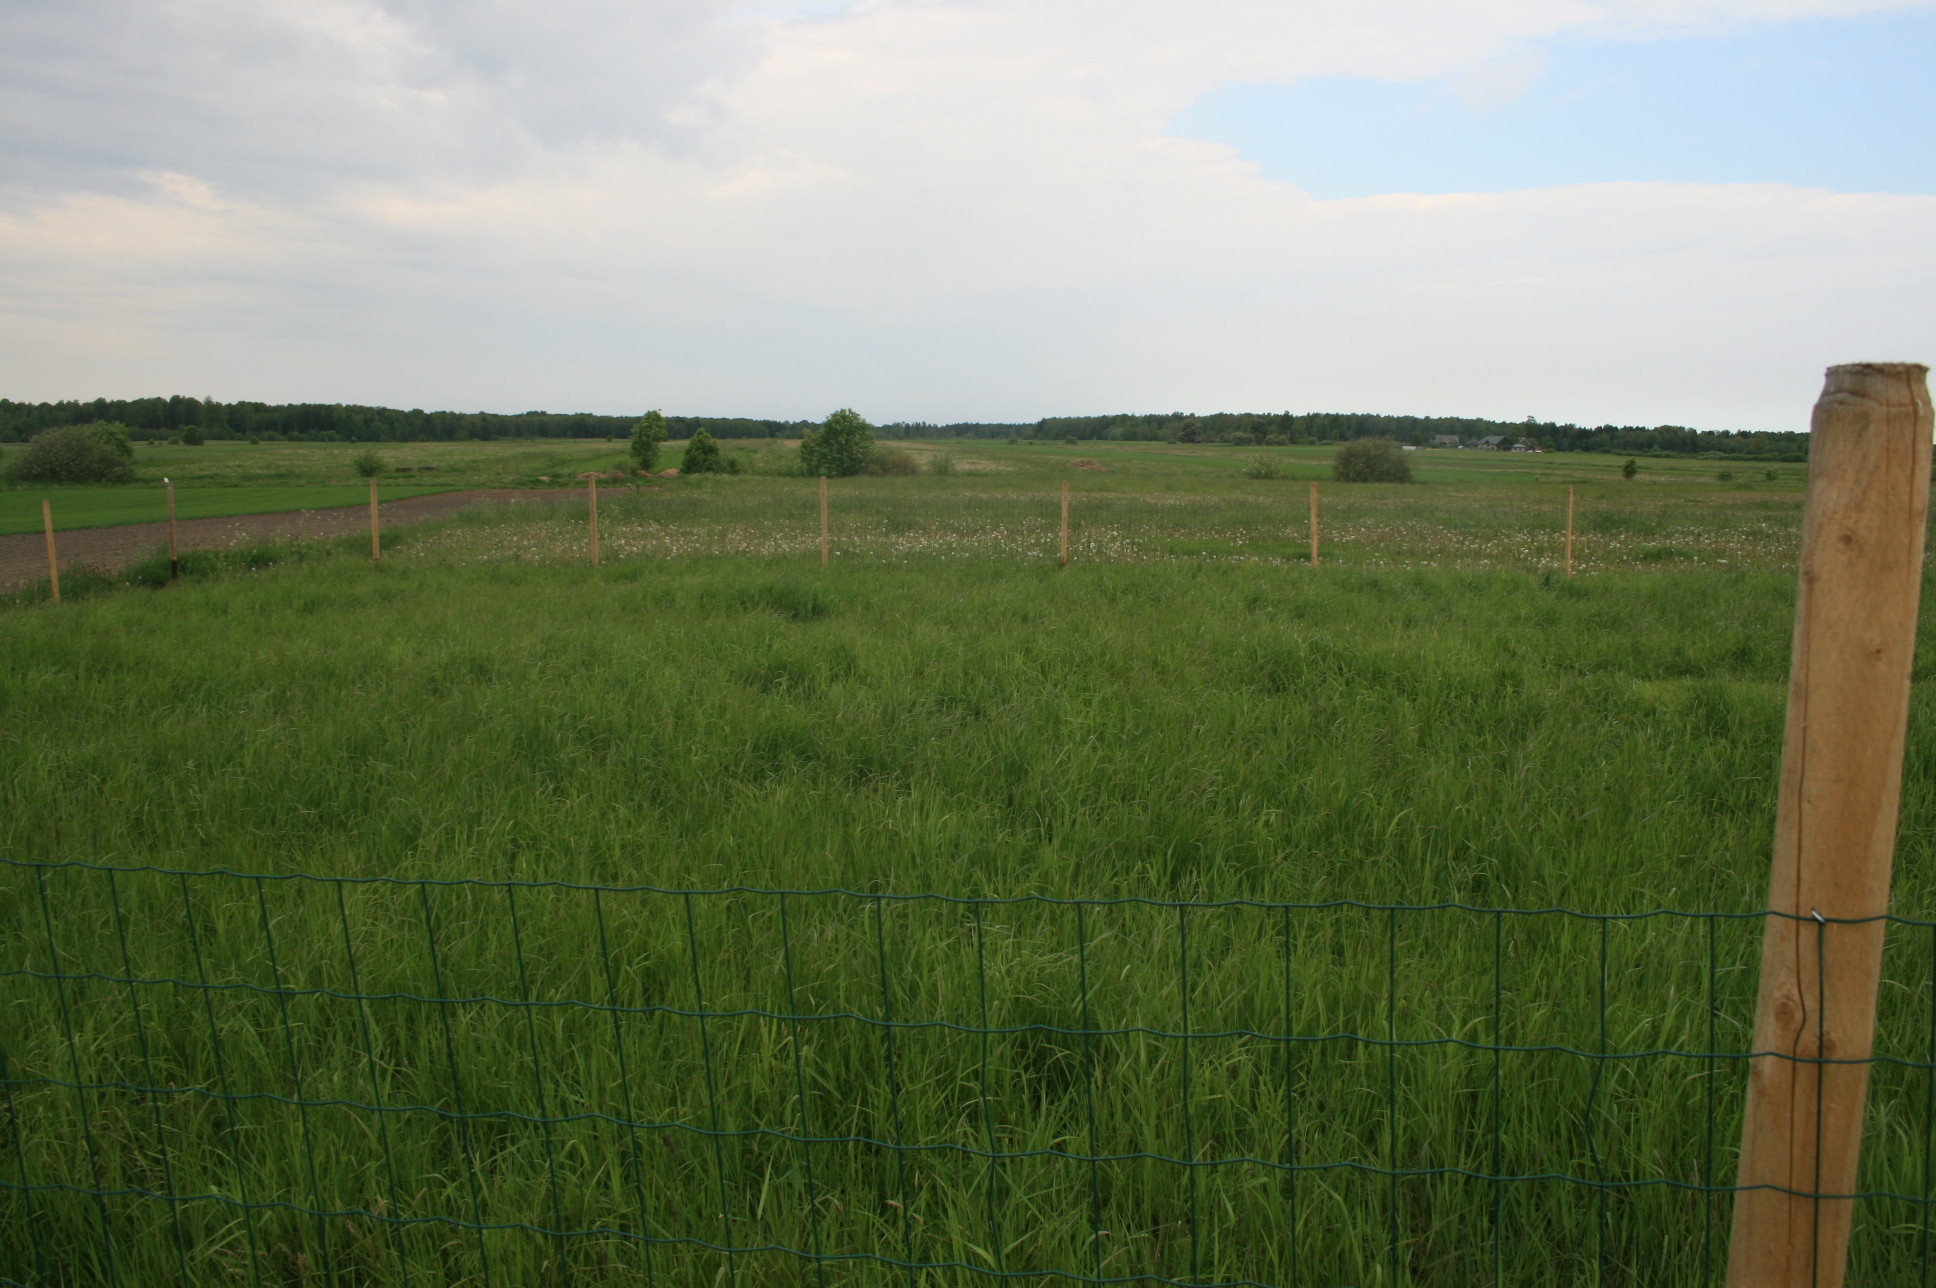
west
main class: Grassland
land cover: Grassland without tree/shrub cover
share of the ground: > 75 %
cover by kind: herbaceous plants 100 %
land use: Agriculture (excluding fallow land and kitchen gardens)
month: May
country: LT
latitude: 55.8010
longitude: 21.6445
